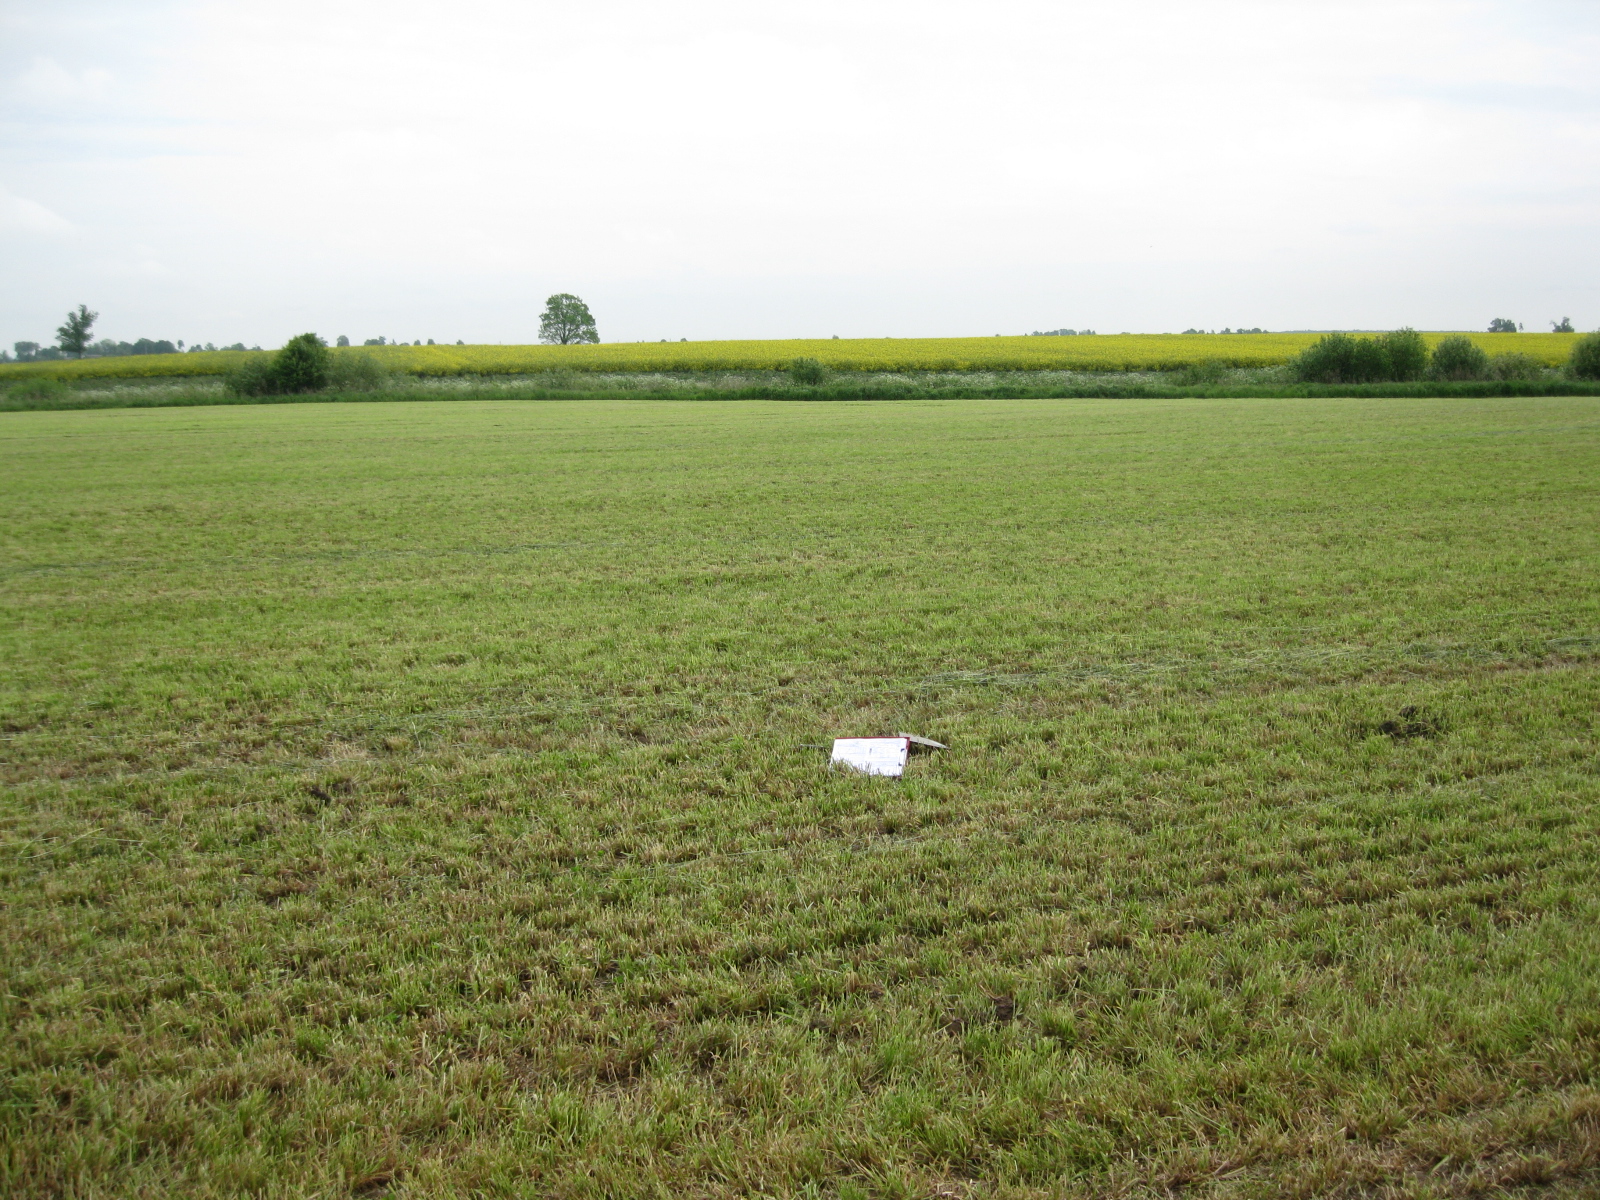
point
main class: Cropland
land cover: Temporary grasslands
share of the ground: > 75 %
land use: Agriculture (excluding fallow land and kitchen gardens)
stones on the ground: < 10 %
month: June
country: LT
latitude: 55.9485
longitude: 24.1341
